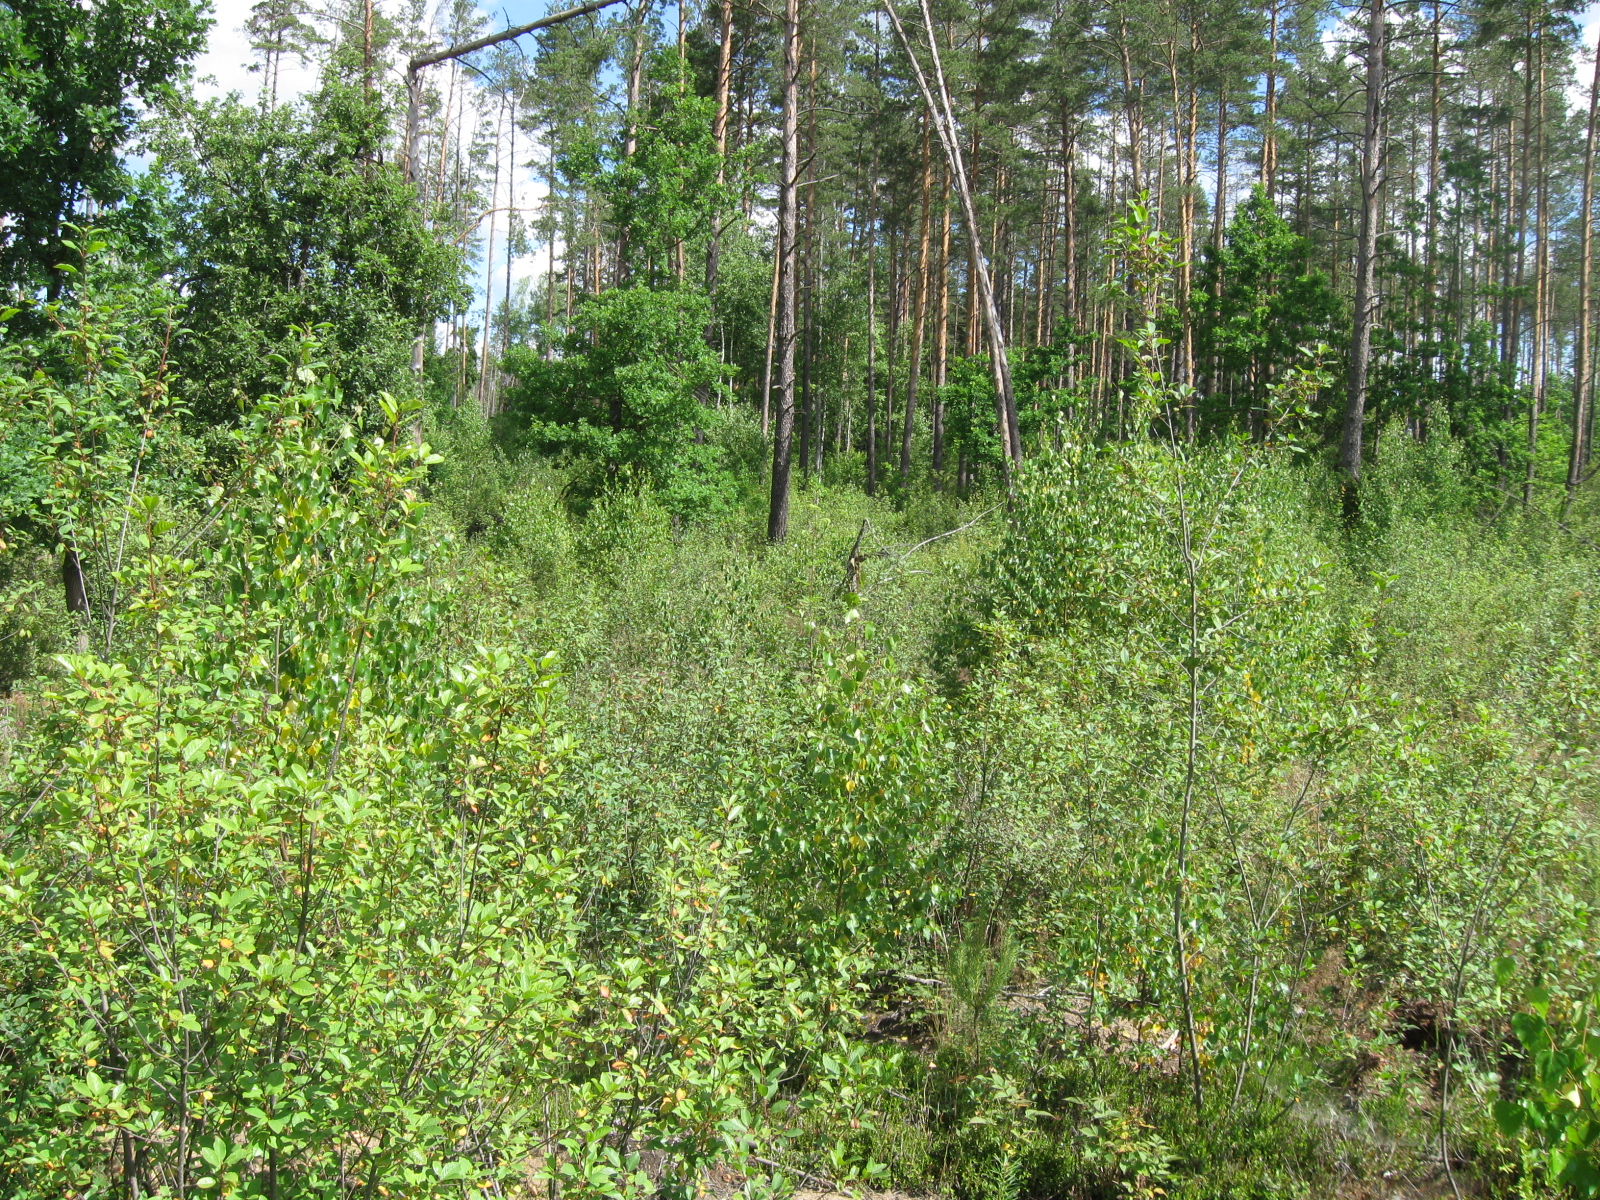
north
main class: Woodland
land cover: Broadleaved woodland
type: non-riverine alder, birch or aspen forest
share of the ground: 50 - 75 %
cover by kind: broadleaved forest trees 65 %, shrubs 15 %, herbaceous plants 15 %, unconsolidated bare surface 5 %
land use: Forestry
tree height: < 5 m
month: July
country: LT
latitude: 54.3281
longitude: 24.5433
